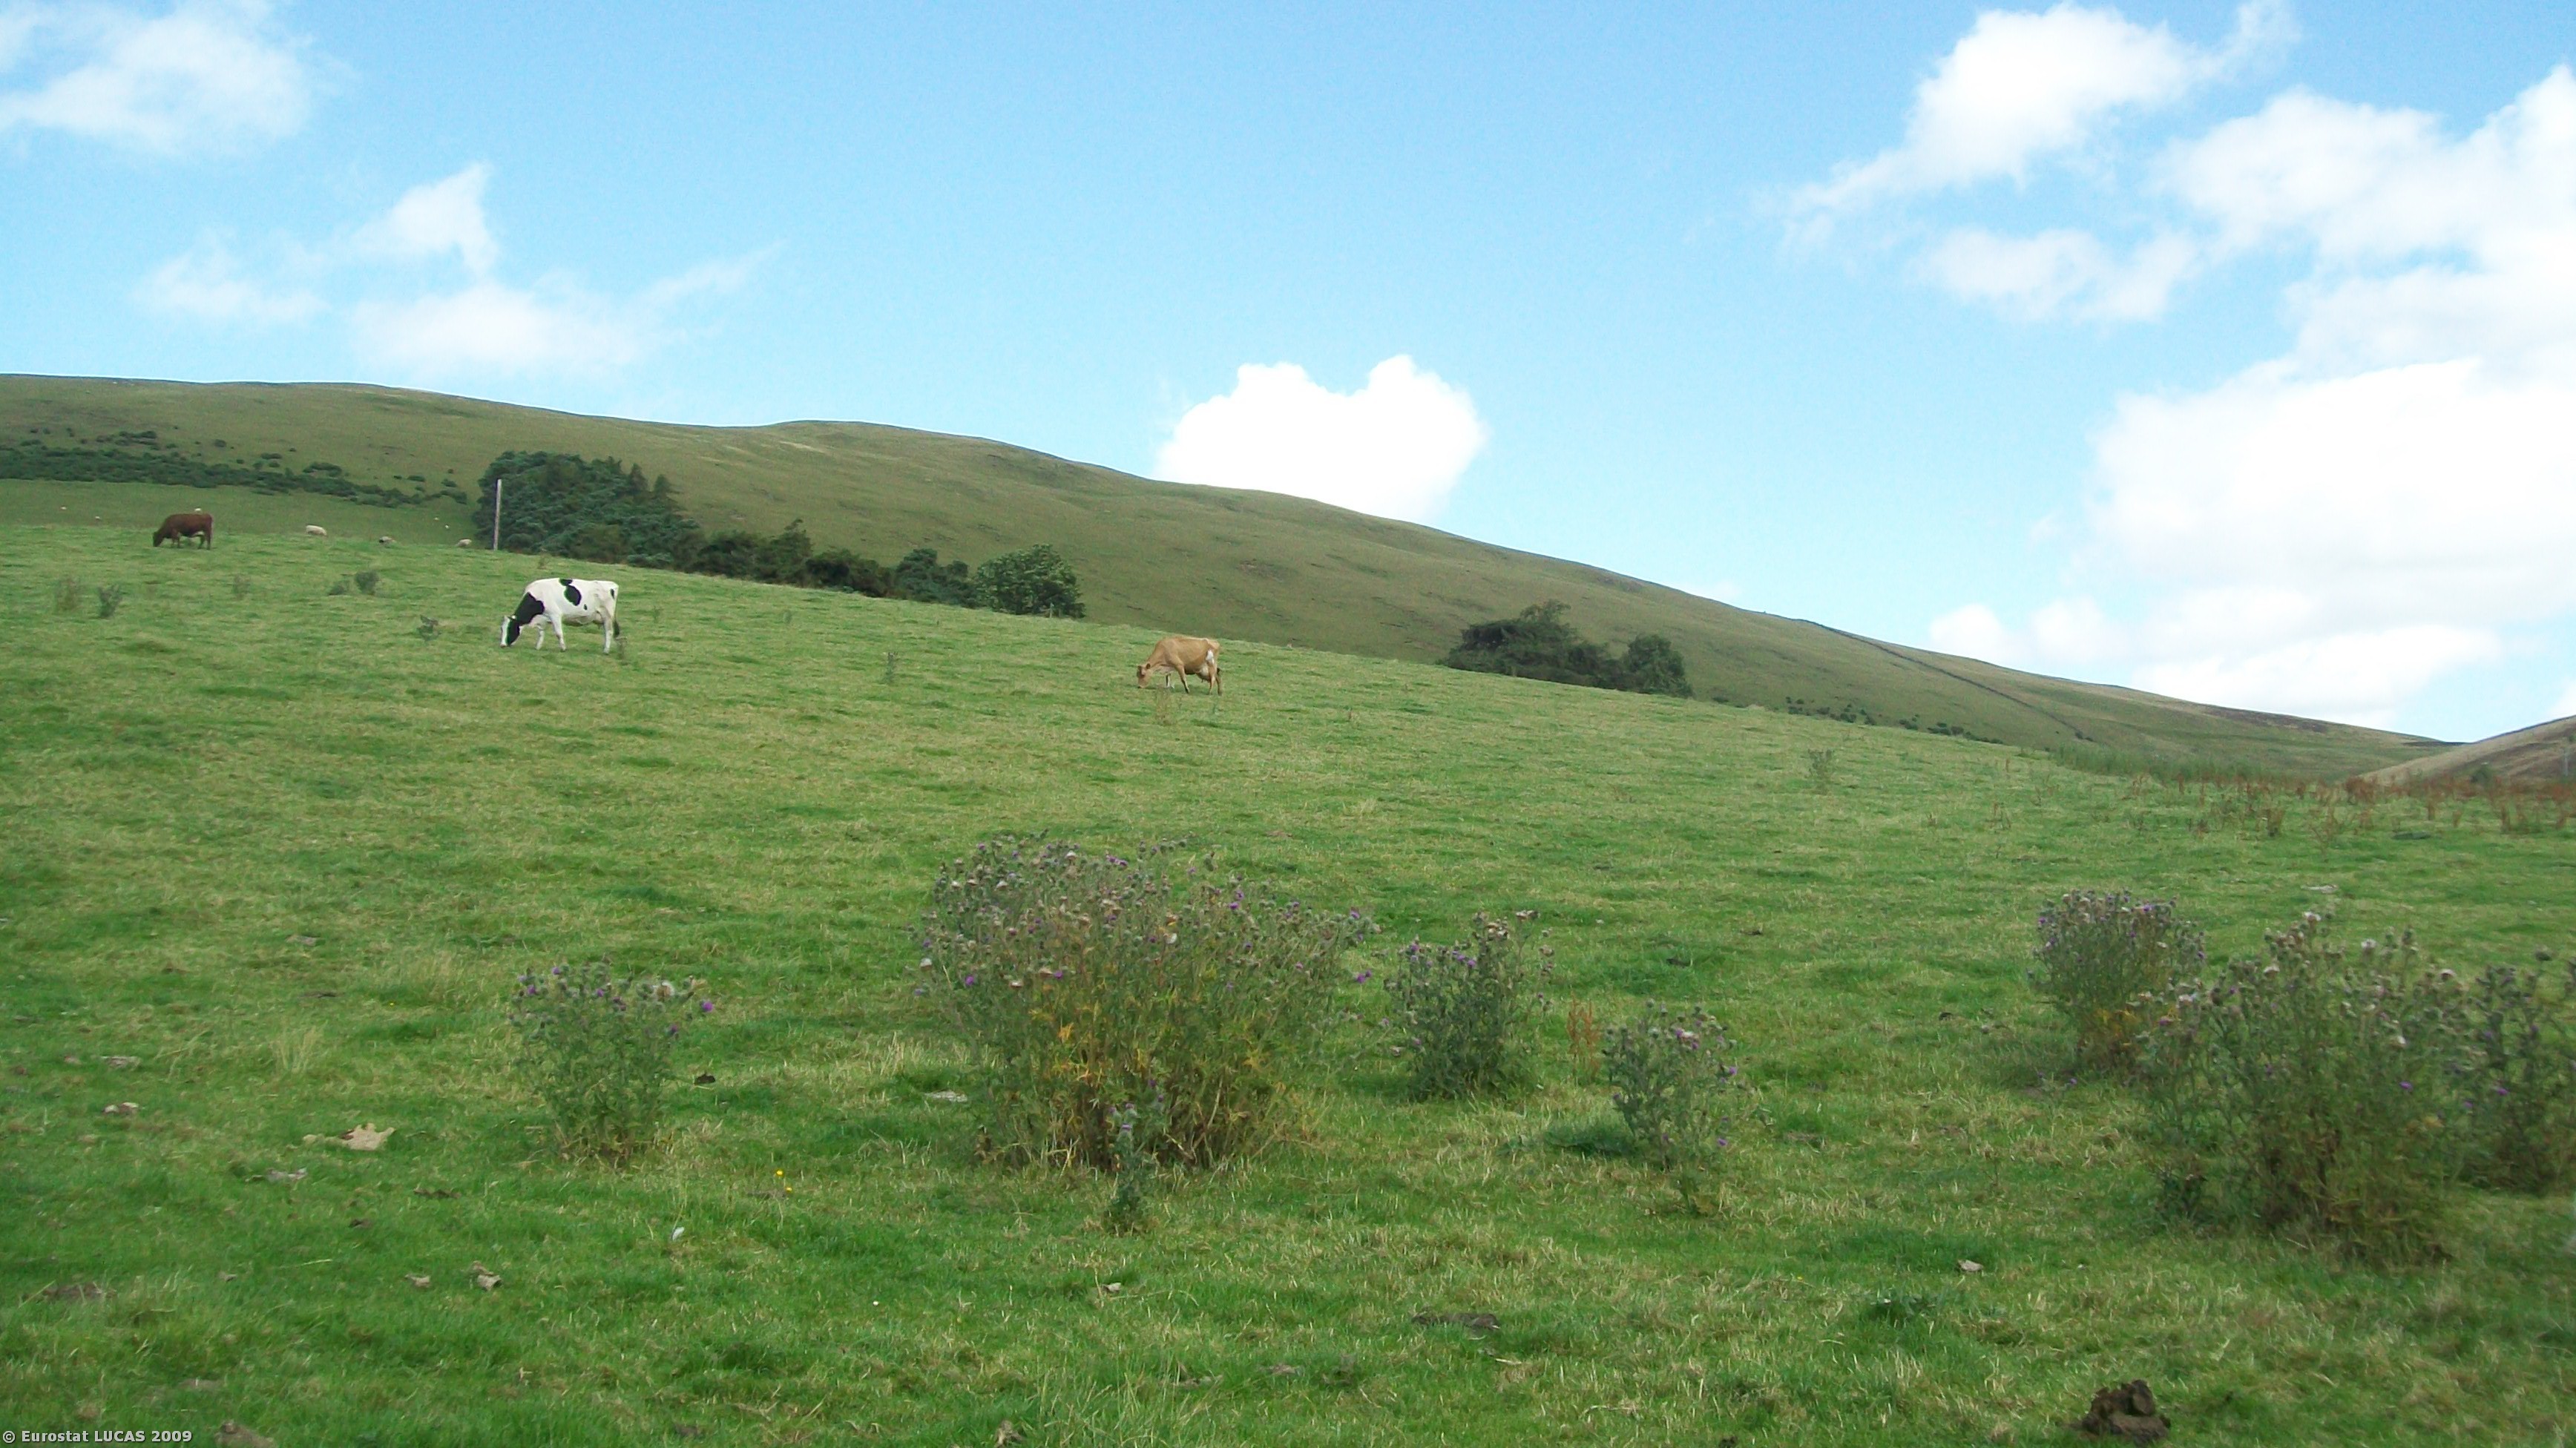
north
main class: Grassland
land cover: Grassland without tree/shrub cover
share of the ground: > 75 %
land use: Agriculture (excluding fallow land and kitchen gardens)
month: August
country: GB
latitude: 55.5989
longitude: -3.4891
